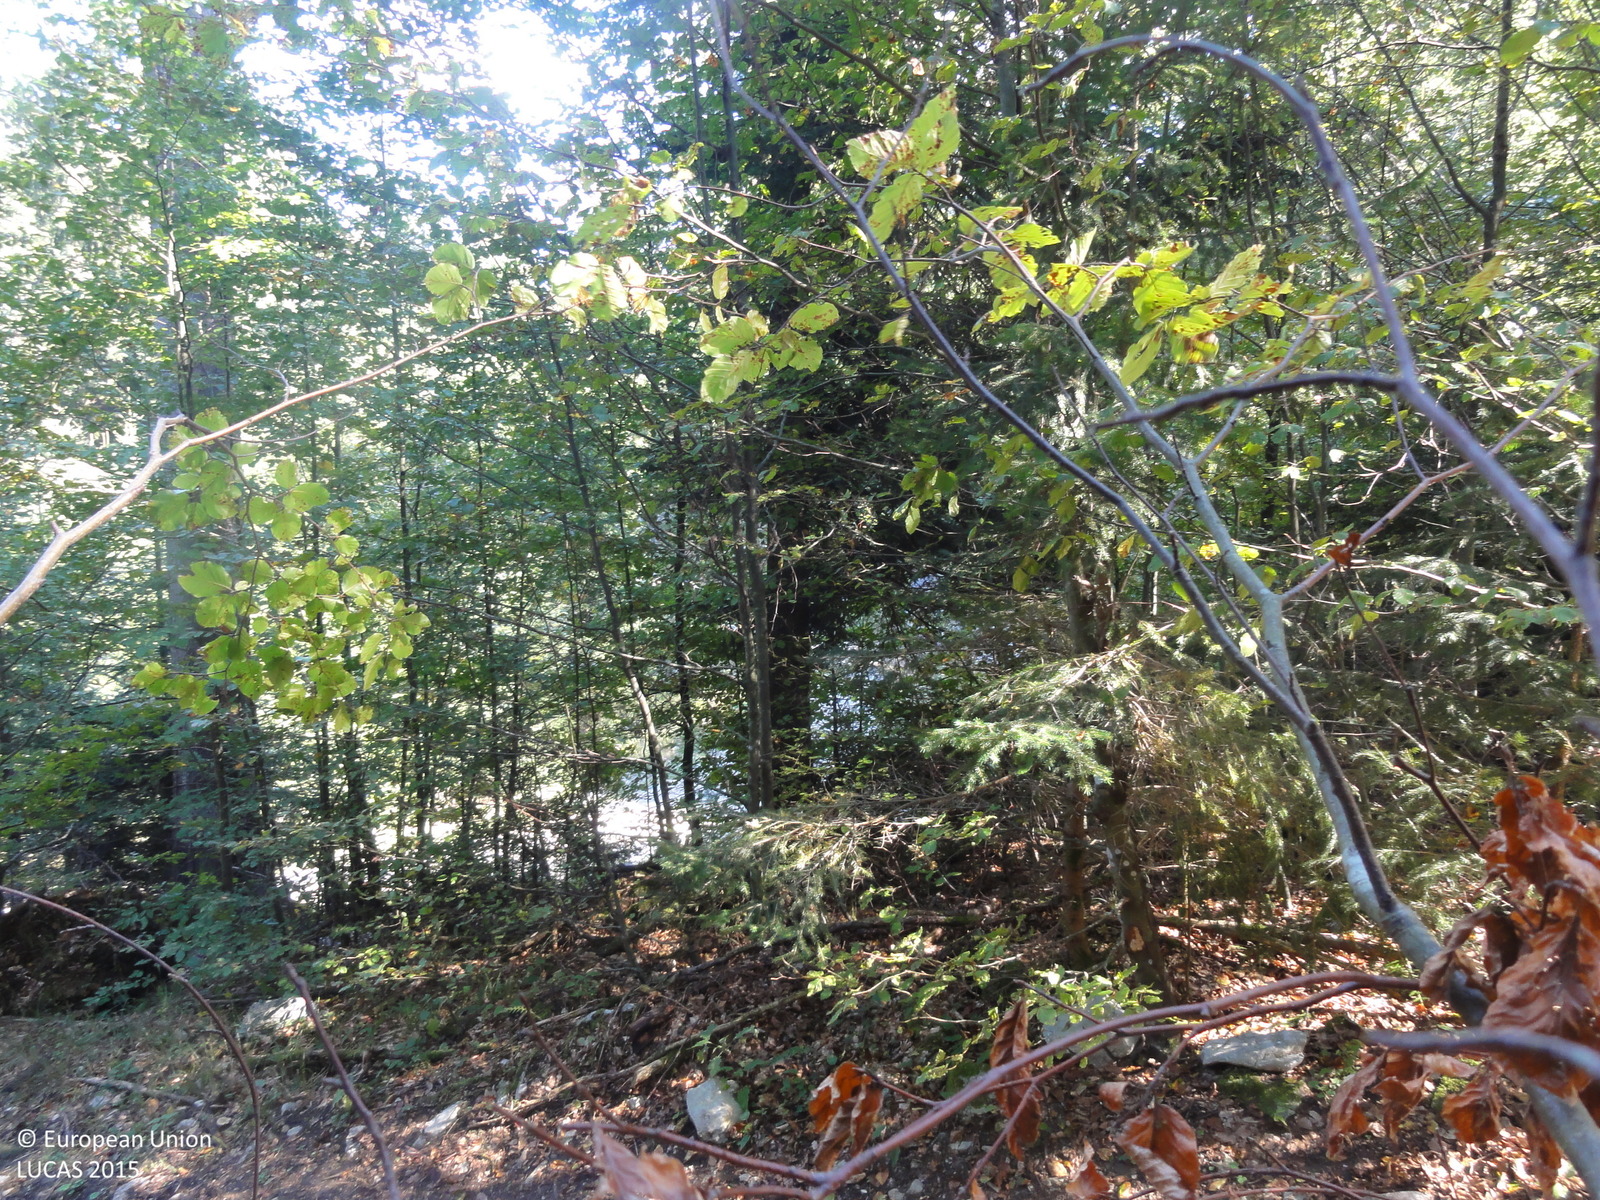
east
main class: Woodland
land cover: Spruce dominated mixed woodland
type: mountainous beech forest
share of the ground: > 75 %
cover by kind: broadleaved forest trees 50 %, coniferous forest trees 30 %, herbaceous plants 10 %, consolidated bare surface 5 %, unconsolidated bare surface 5 %
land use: Forestry
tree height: > 5 m
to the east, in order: Spruce dominated mixed woodland; Tracks; Spruce dominated mixed woodland; Grass margins; Tracks; Grass margins; Spruce dominated coniferous woodland; Tracks; Spruce dominated mixed woodland; Tracks; Spruce dominated mixed woodland; Tracks; Spruce dominated mixed woodland; Tracks; Spruce dominated mixed woodland
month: September
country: SI
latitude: 45.7112
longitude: 14.9931
